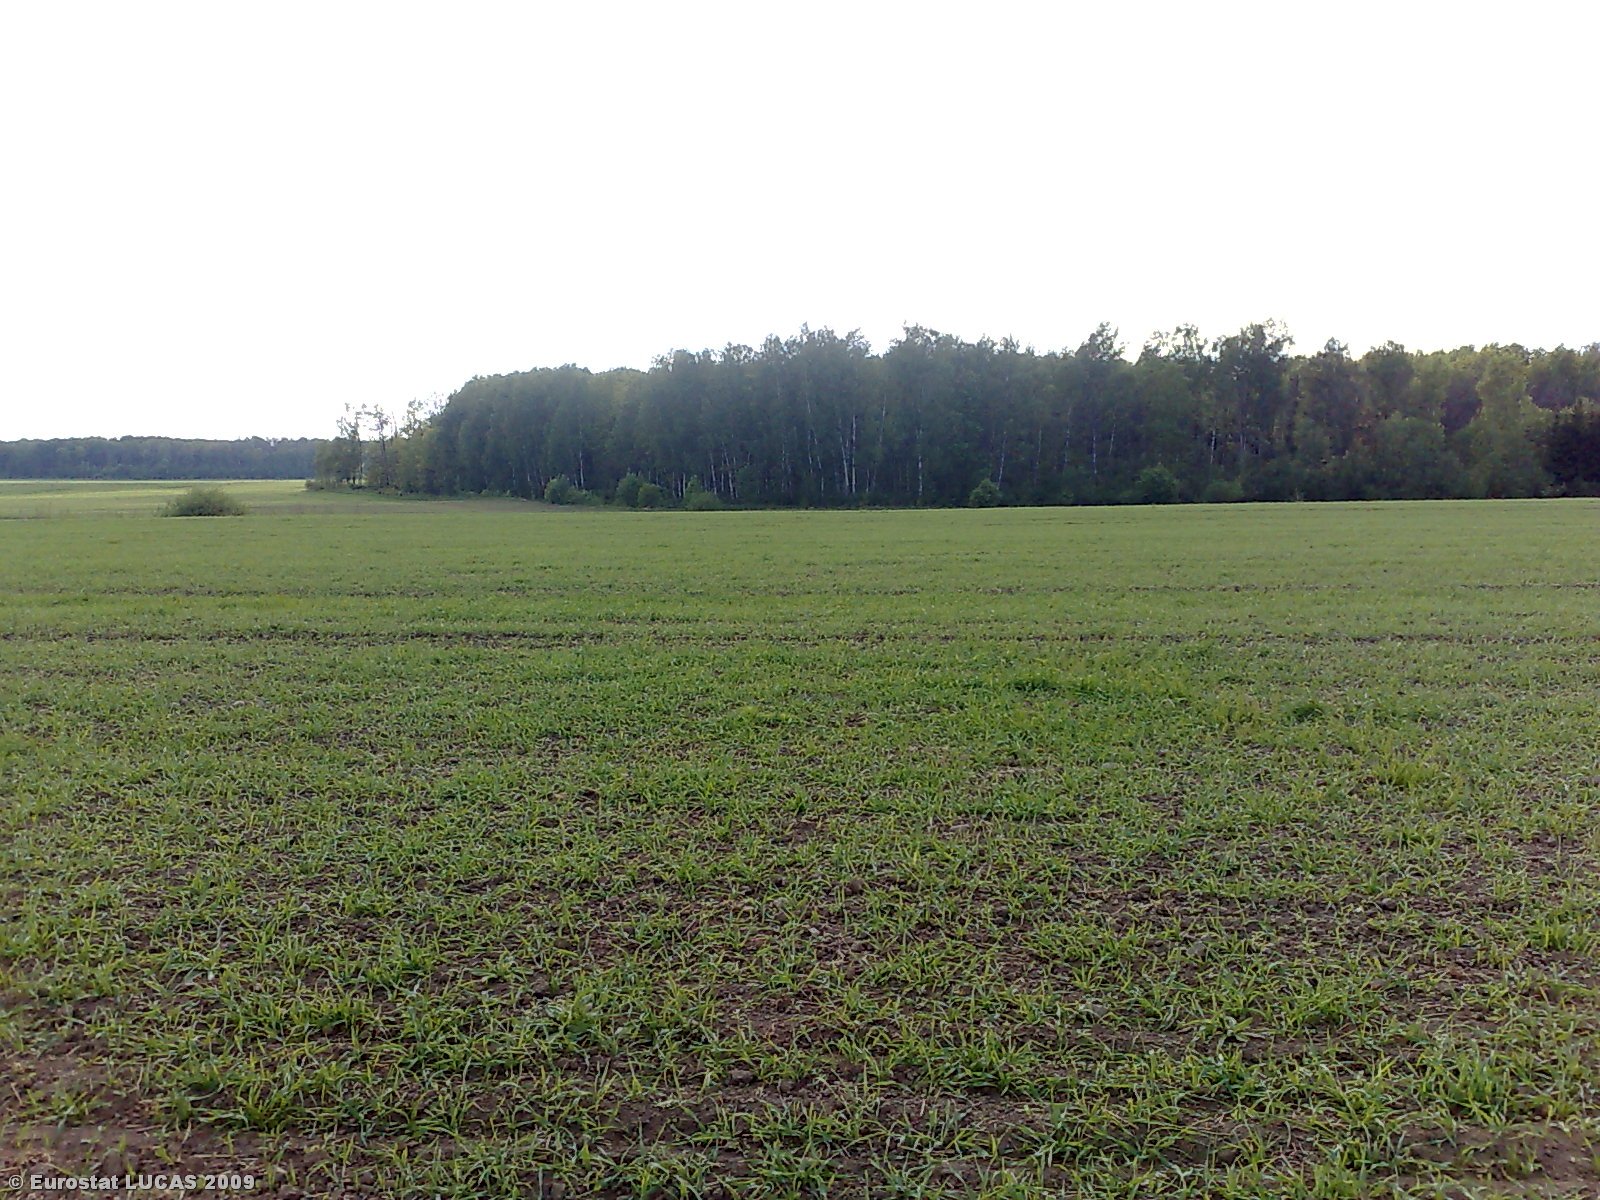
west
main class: Cropland
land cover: Barley
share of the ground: 50 - 75 %
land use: Agriculture (excluding fallow land and kitchen gardens)
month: May
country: LT
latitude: 55.8533
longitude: 23.8383
